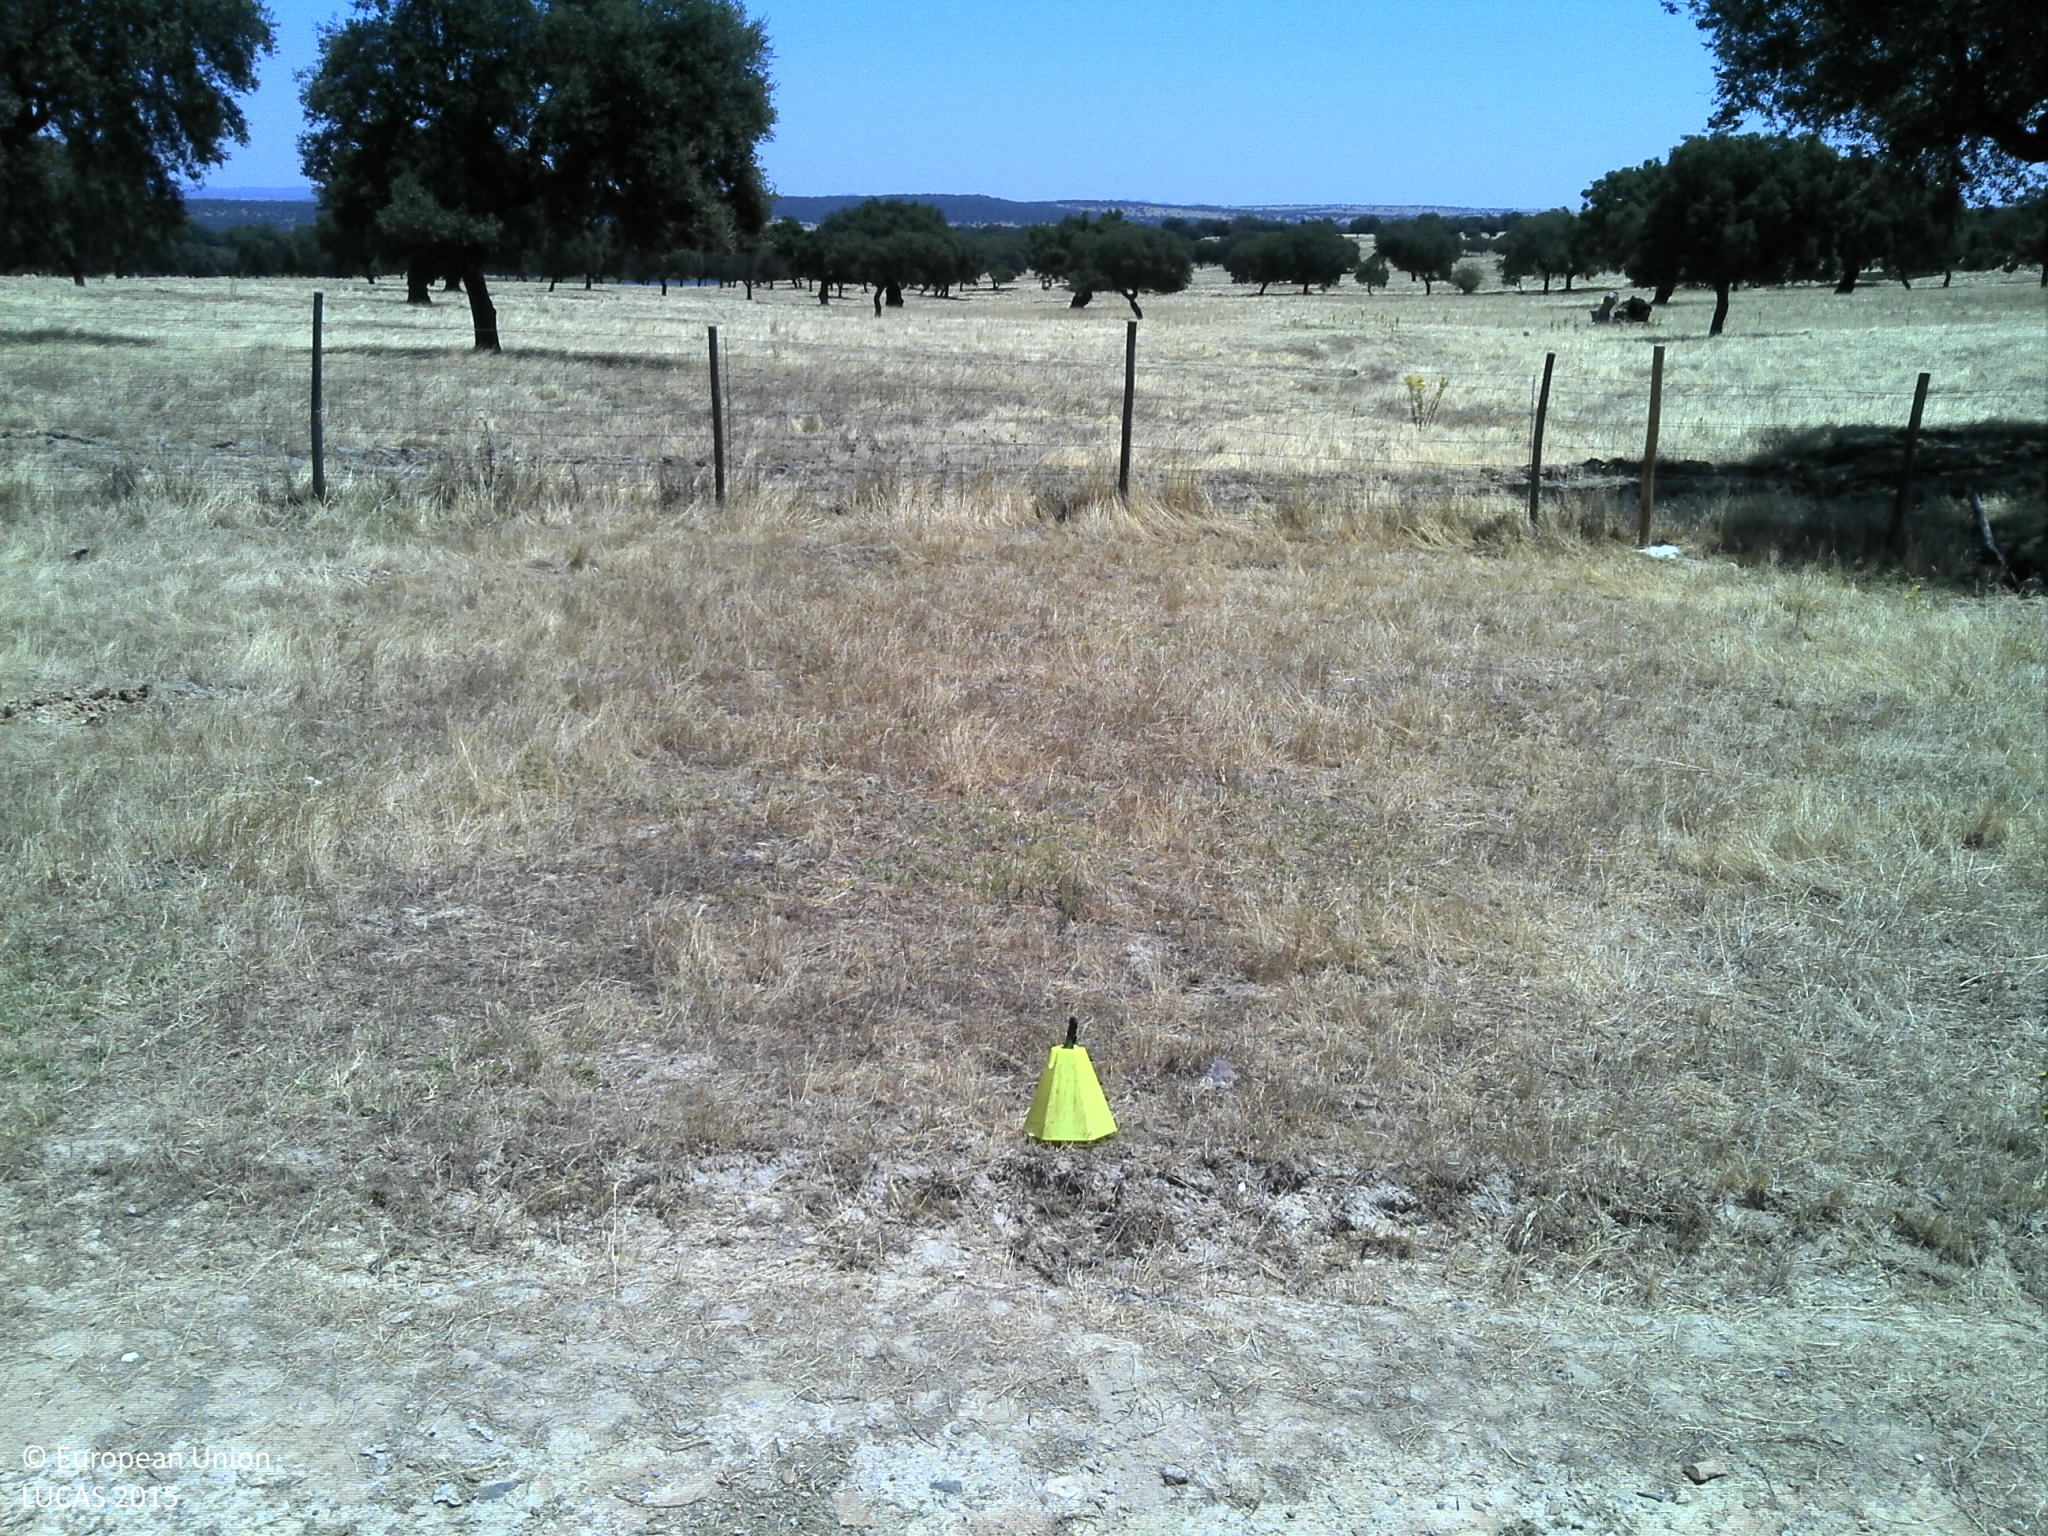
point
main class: Grassland
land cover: Grassland without tree/shrub cover
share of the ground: 25 - 50 %
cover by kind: unconsolidated bare surface 70 %, herbaceous plants 30 %
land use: Agriculture (excluding fallow land and kitchen gardens)
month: July
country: PT
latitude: 39.1382
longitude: -7.5219
